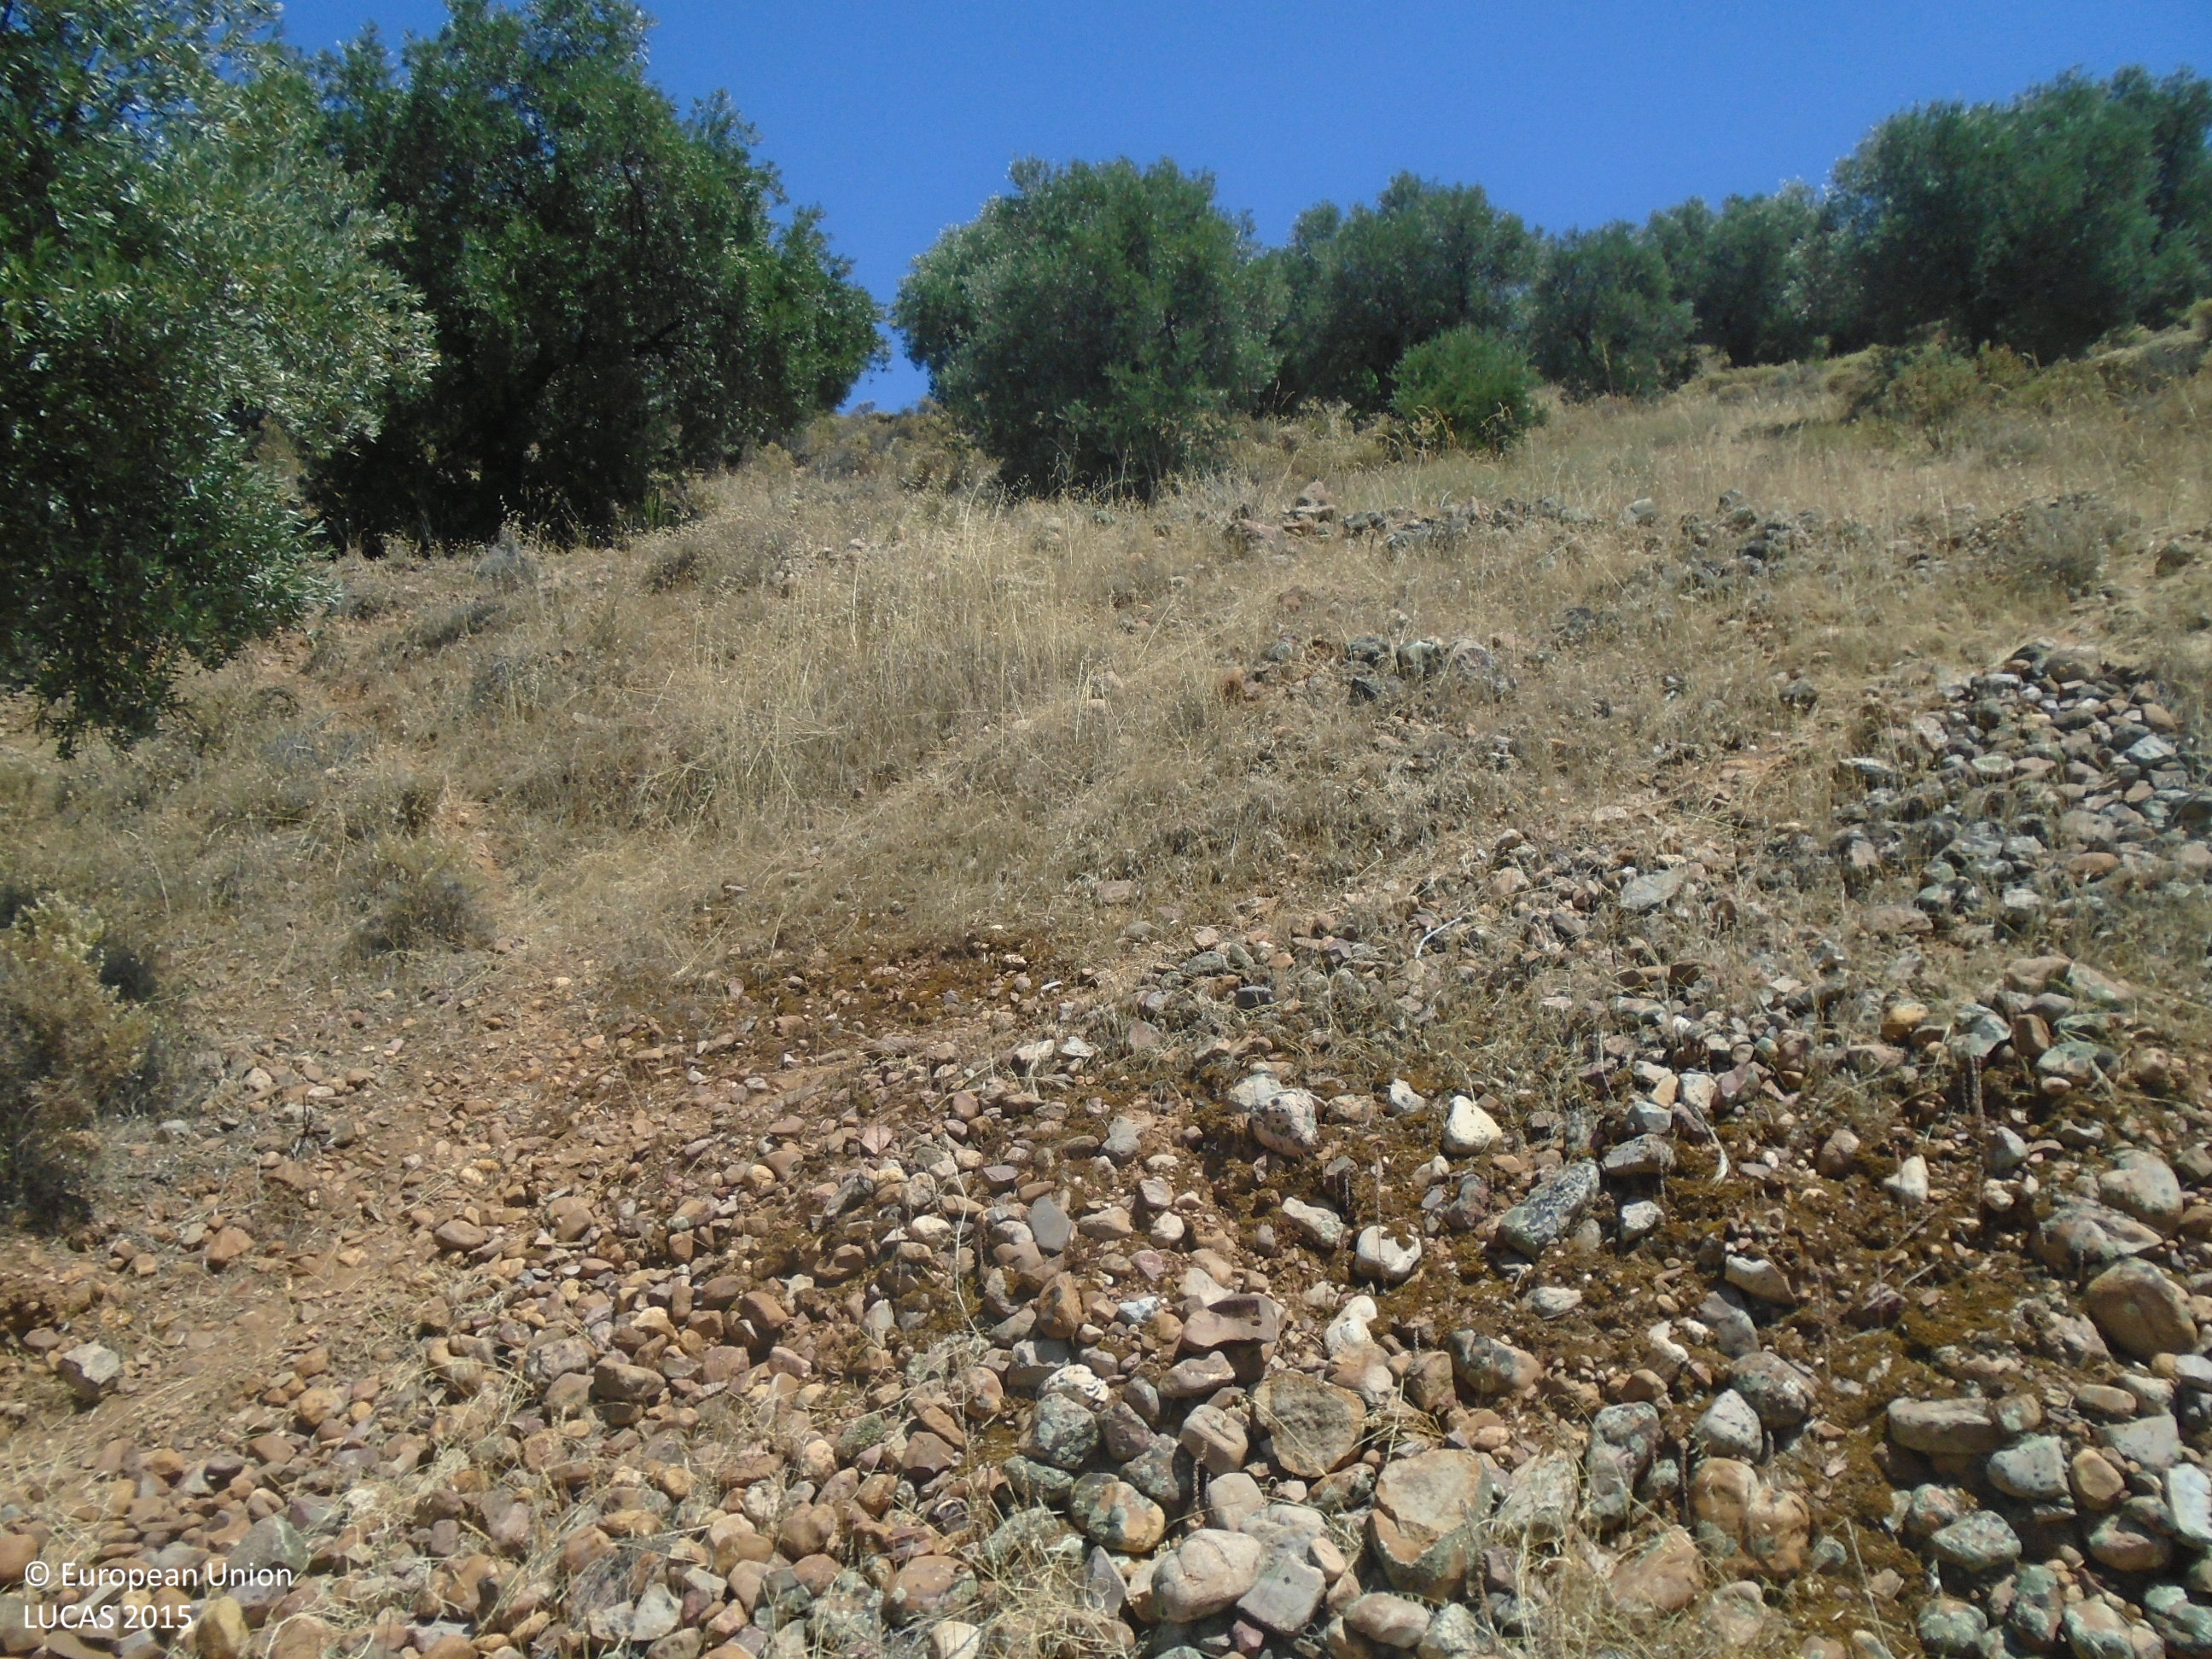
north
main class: Cropland
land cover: Olive groves
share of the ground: 10 - 25 %
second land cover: Spontaneously vegetated surfaces
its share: > 75 %
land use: Agriculture (excluding fallow land and kitchen gardens)
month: July
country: ES
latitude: 39.7394
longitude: -4.9477
